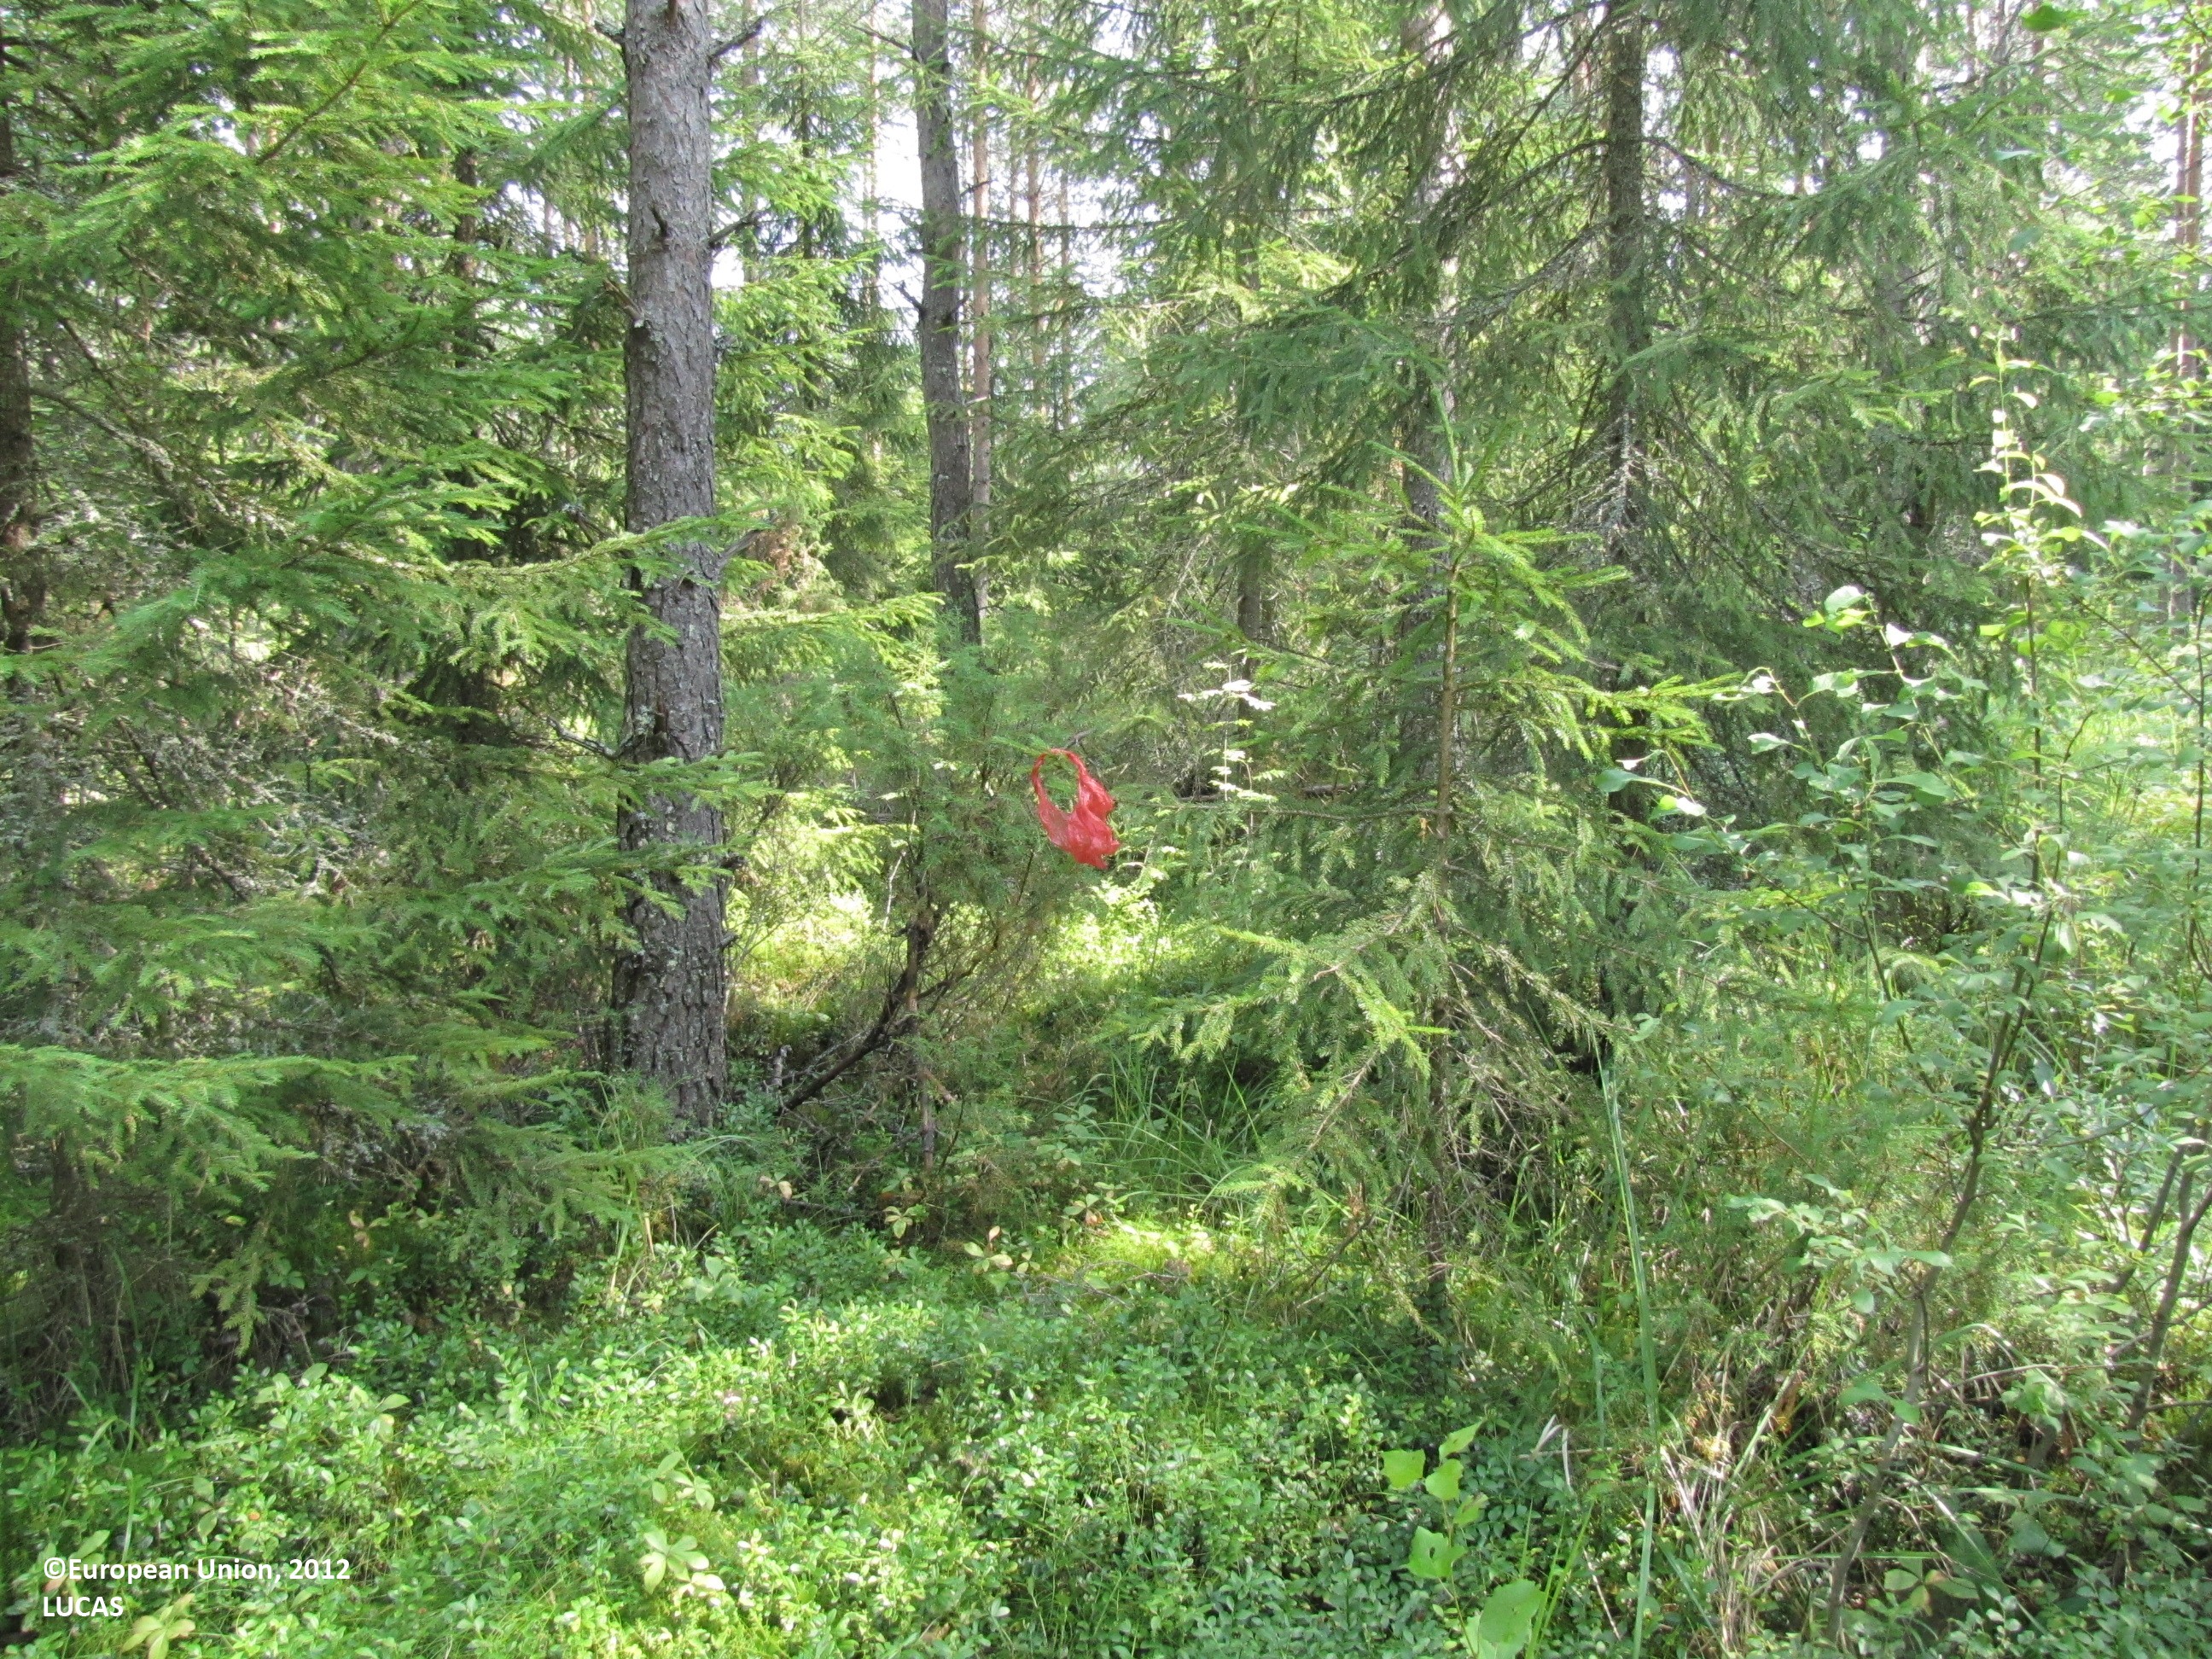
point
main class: Woodland
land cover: Other coniferous woodland
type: boreal forest
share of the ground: 50 - 75 %
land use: Forestry
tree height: > 5 m
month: July
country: FI
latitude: 62.0037
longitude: 23.2668
